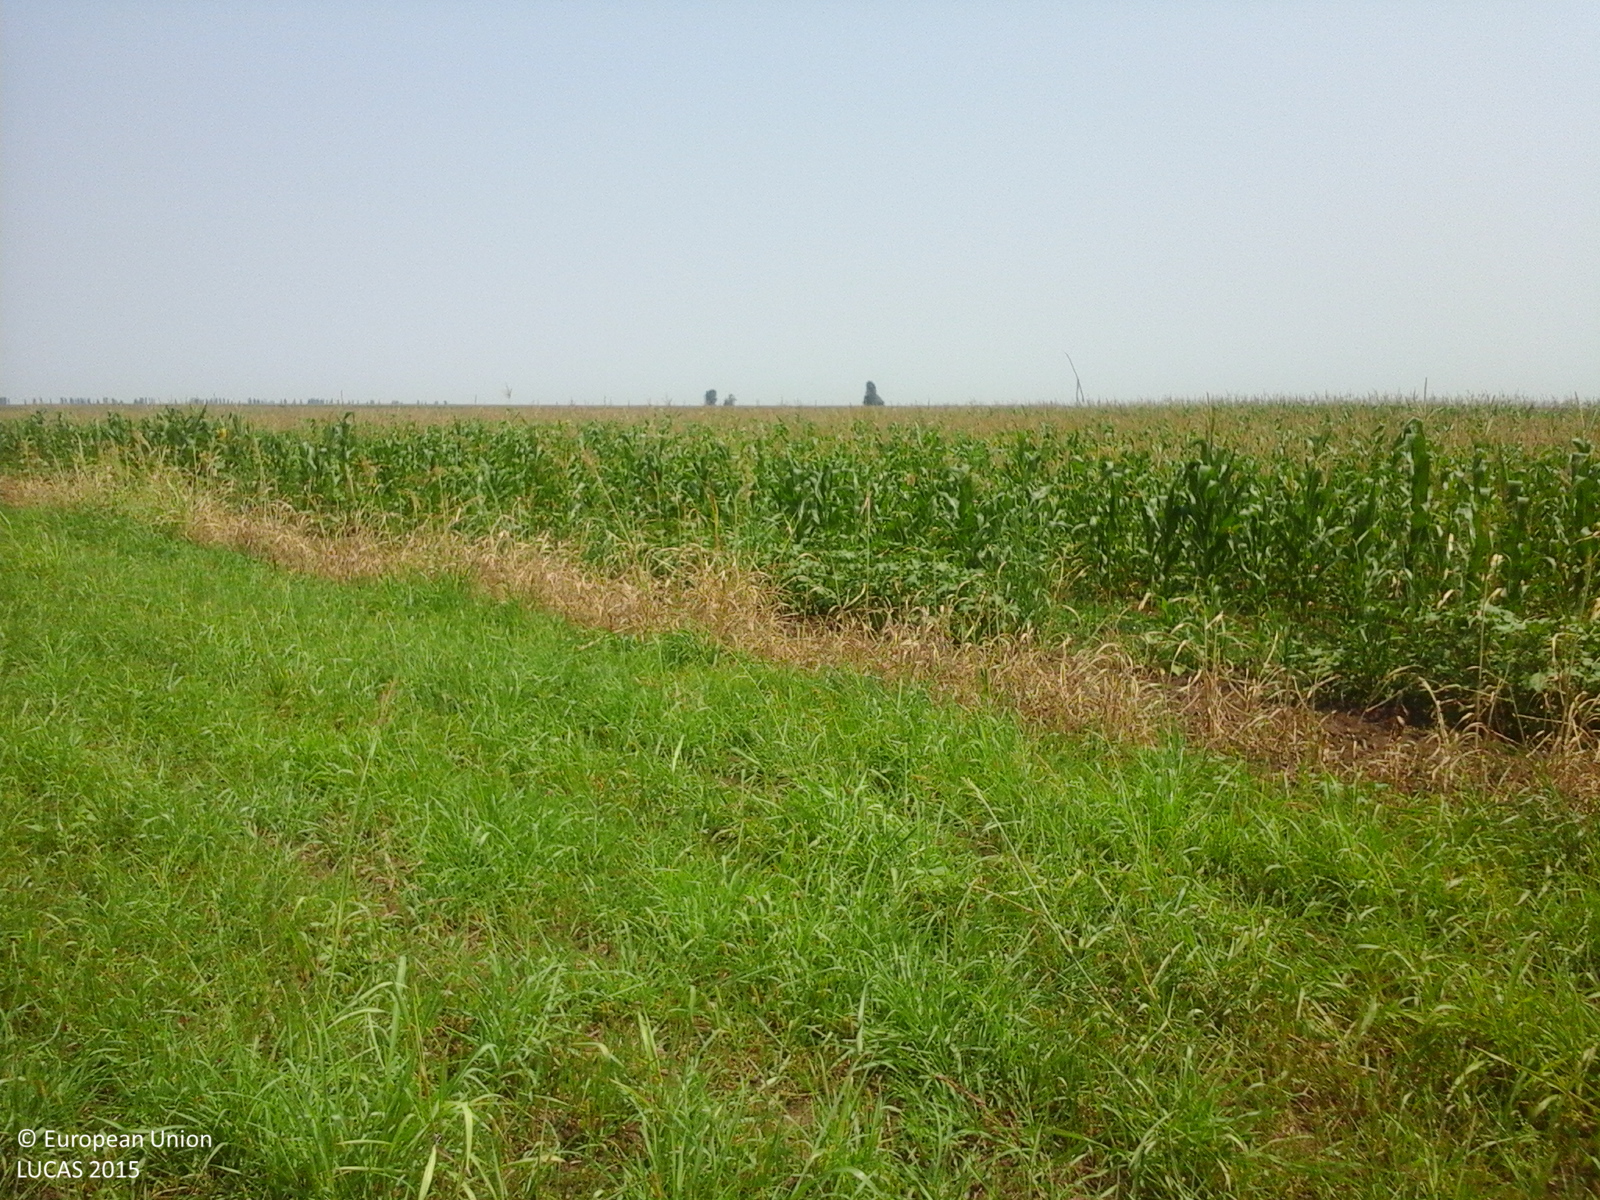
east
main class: Grassland
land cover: Grassland without tree/shrub cover
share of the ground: > 75 %
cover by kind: herbaceous plants 100 %
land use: Agriculture (excluding fallow land and kitchen gardens)
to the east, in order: Grassland without tree/shrub cover; Maize; Common wheat; Grass margins; Tracks; Grass margins; Maize
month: July
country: RO
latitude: 44.8530
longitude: 26.6357
